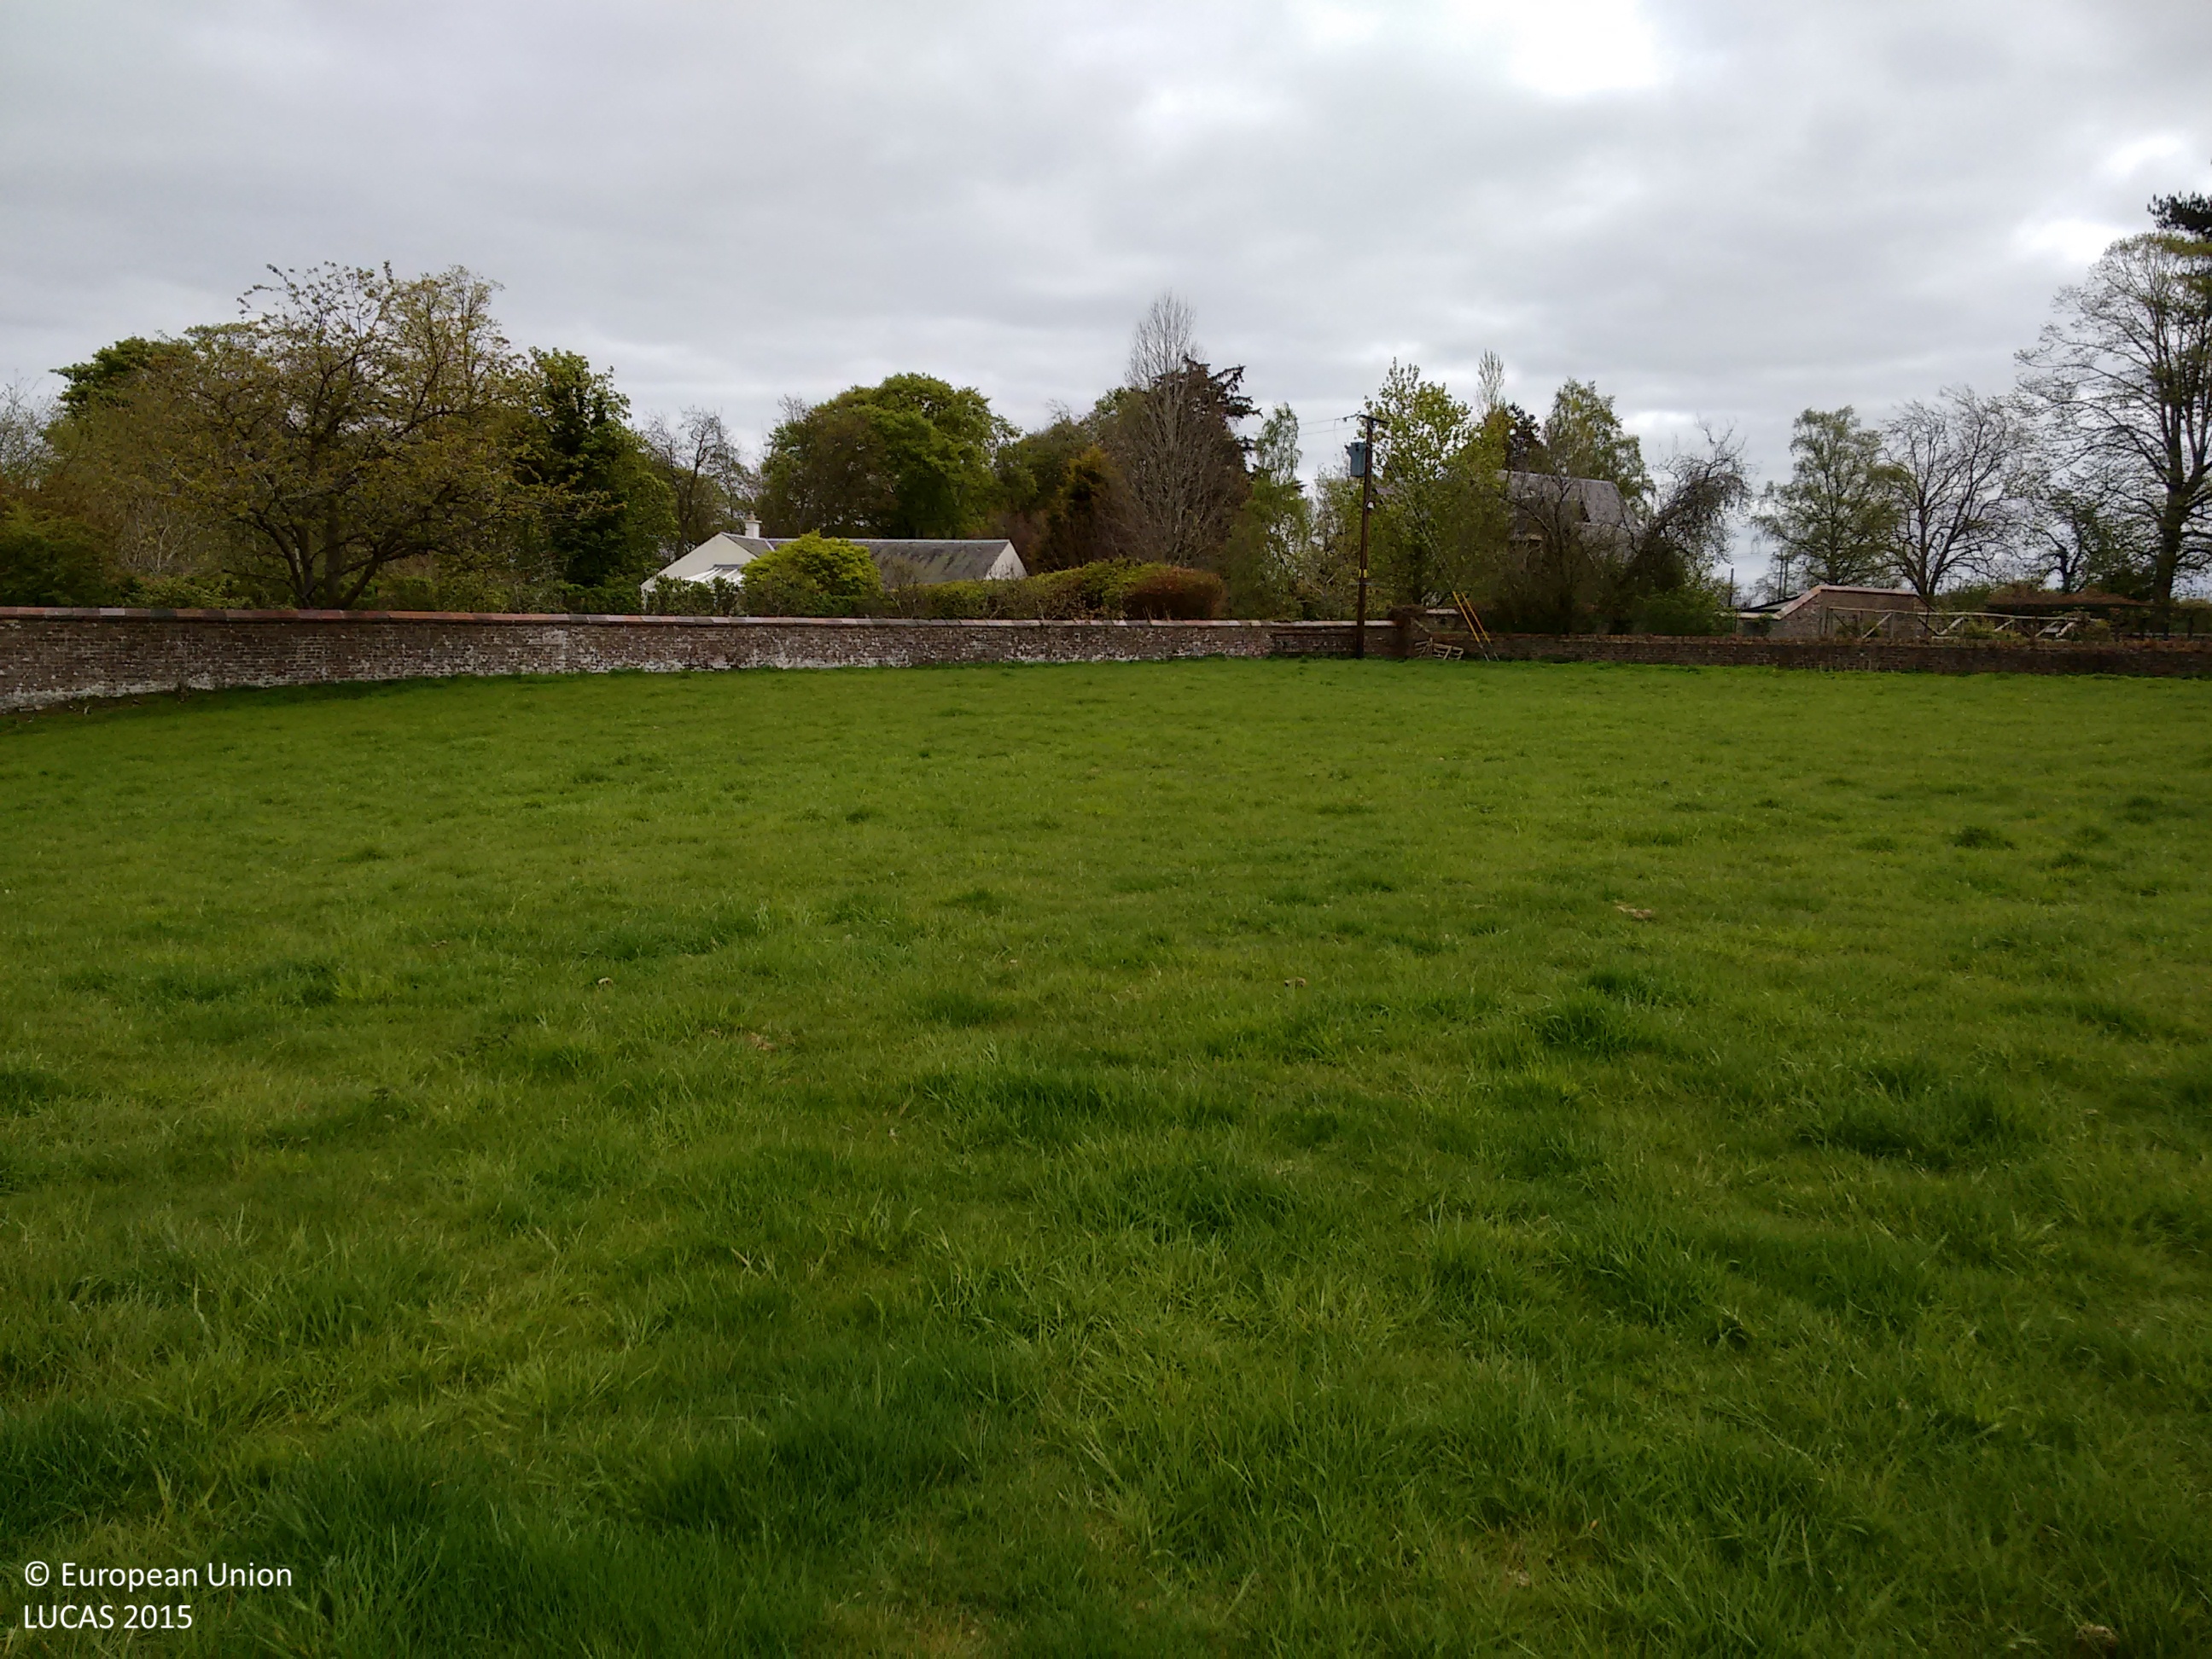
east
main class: Grassland
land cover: Grassland without tree/shrub cover
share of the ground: > 75 %
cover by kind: herbaceous plants 100 %
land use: Agriculture (excluding fallow land and kitchen gardens)
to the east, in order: Grassland without tree/shrub cover; Artificial constructions in urban areas; Broadleaved woodland; Paved roads, cycling and walking lanes; Grass margins; Fences; Electric lines; Grassland with sparse tree/shrub cover; Barley; Electric lines; Barley
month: May
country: GB
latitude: 55.8534
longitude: -3.1541
